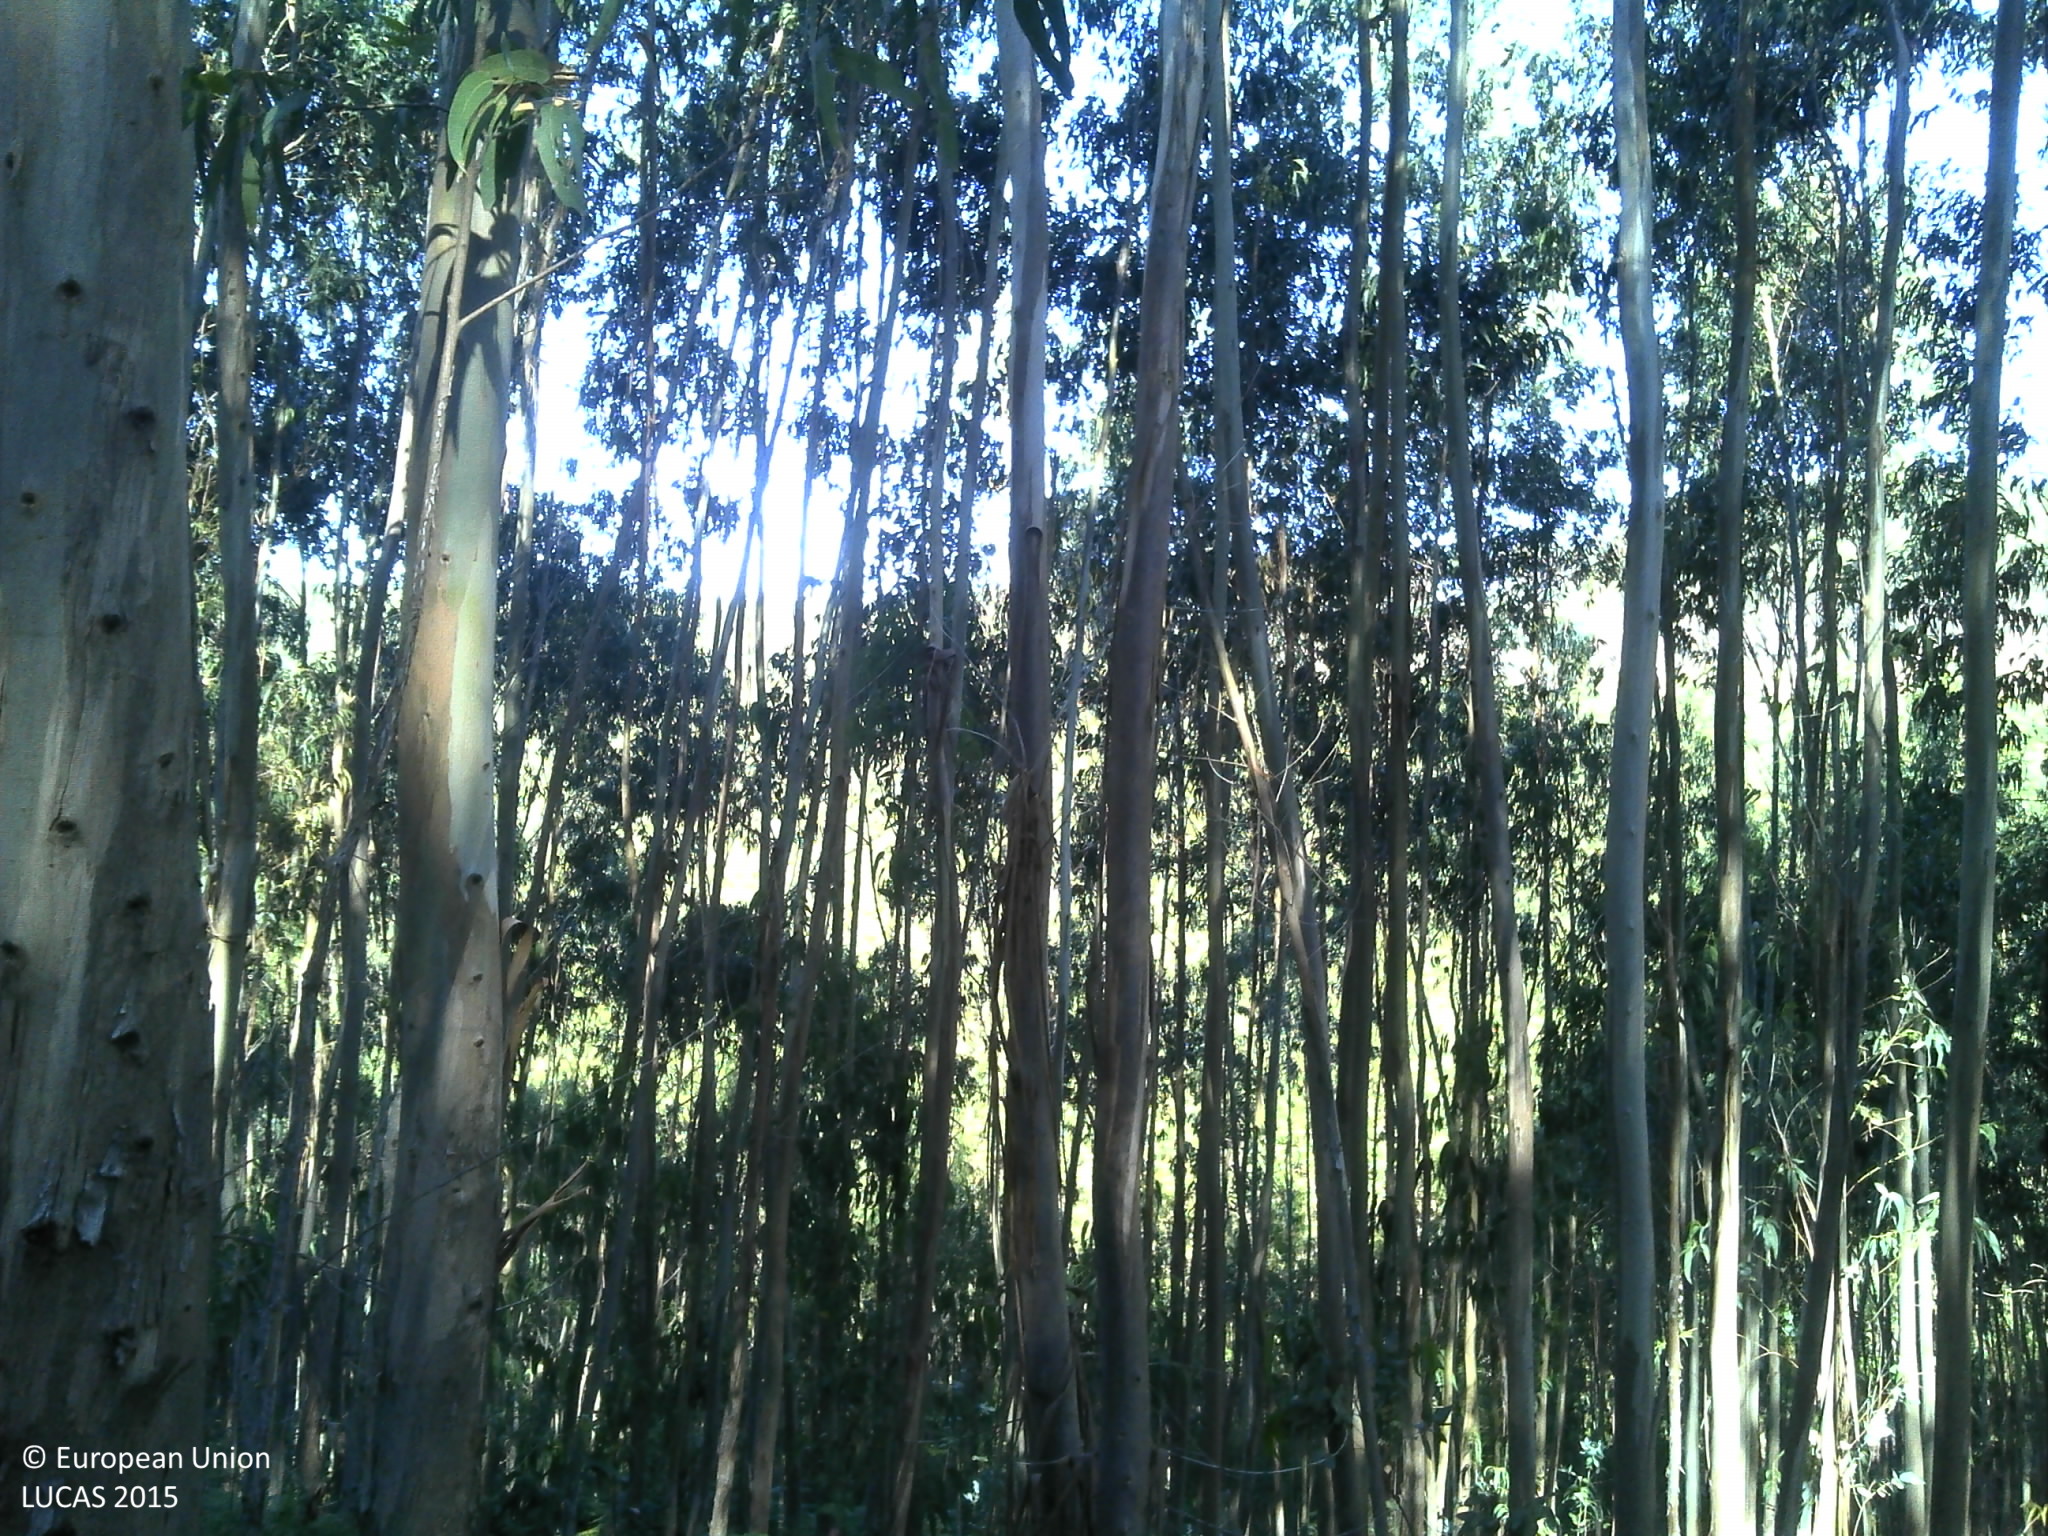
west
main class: Woodland
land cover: Broadleaved woodland
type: exotic forest
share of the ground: 50 - 75 %
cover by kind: broadleaved forest trees 75 %, shrubs 15 %, unconsolidated bare surface 10 %
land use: Forestry
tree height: > 5 m
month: June
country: PT
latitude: 40.4826
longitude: -8.2382
